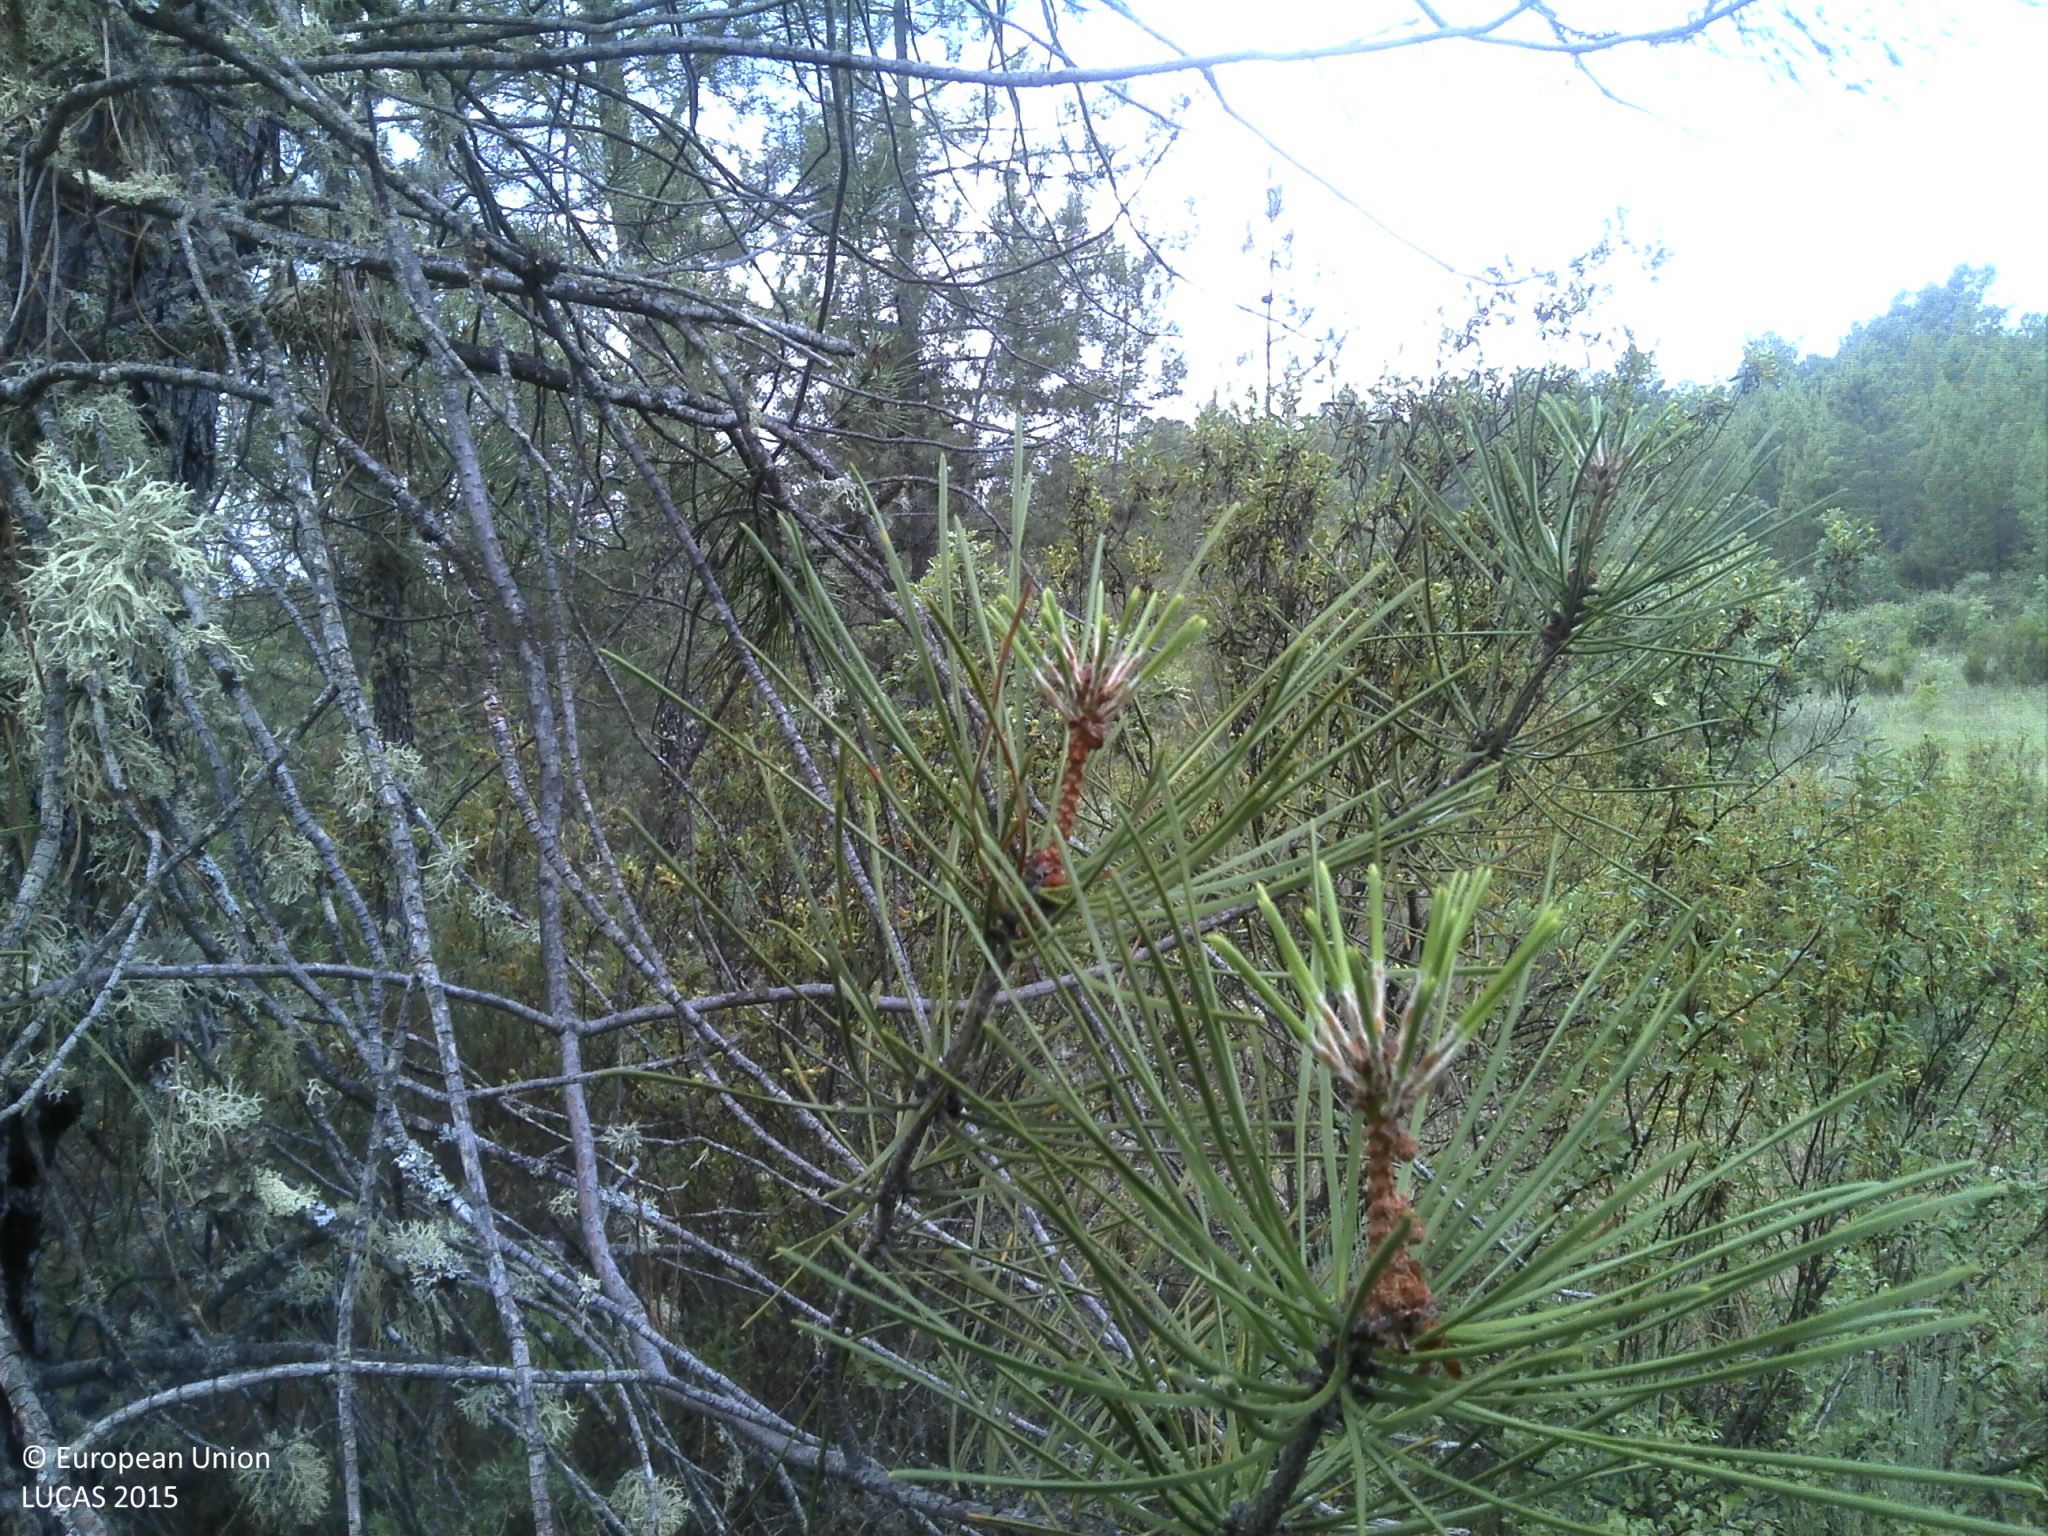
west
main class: Woodland
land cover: Pine dominated coniferous woodland
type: coniferous forest of the mediterranean region
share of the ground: 50 - 75 %
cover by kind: coniferous forest trees 60 %, shrubs 30 %, unconsolidated bare surface 5 %
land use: Forestry
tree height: > 5 m
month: June
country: PT
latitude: 40.2133
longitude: -7.2911
